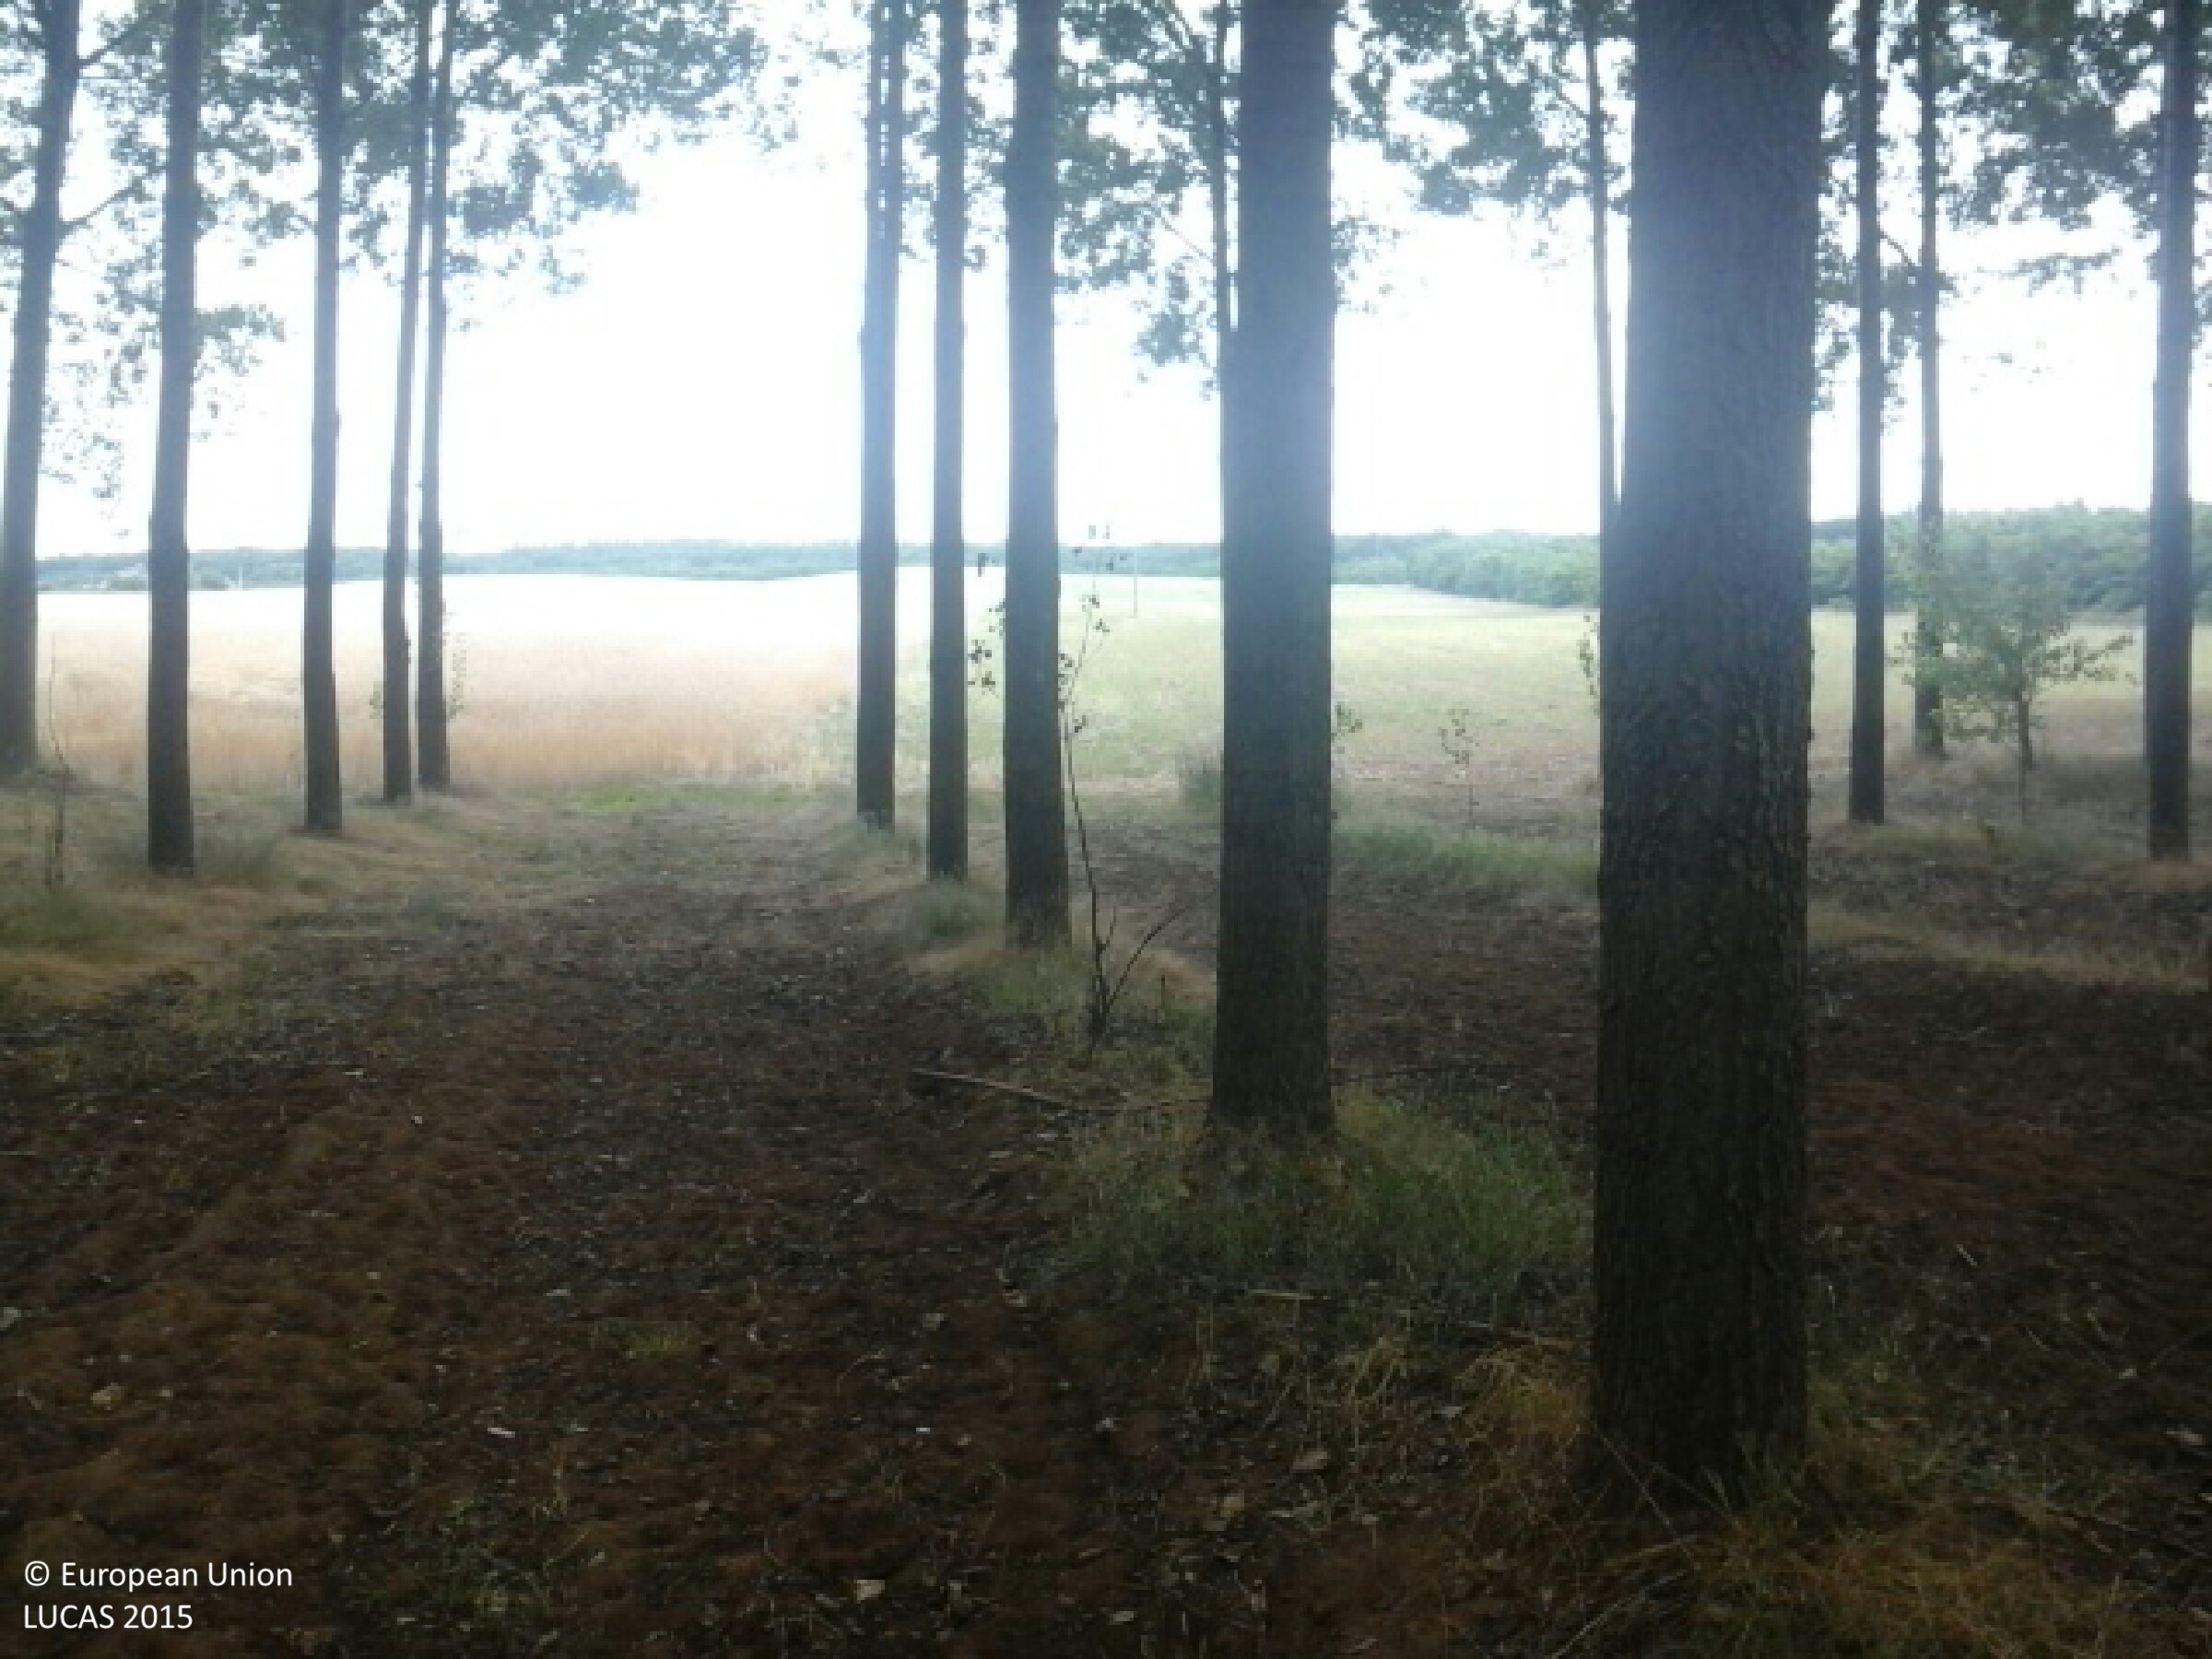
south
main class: Woodland
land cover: Broadleaved woodland
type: non-riverine alder, birch or aspen forest
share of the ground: > 75 %
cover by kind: broadleaved forest trees 100 %
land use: Forestry
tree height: > 5 m
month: June
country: HU
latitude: 48.0735
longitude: 22.1746
